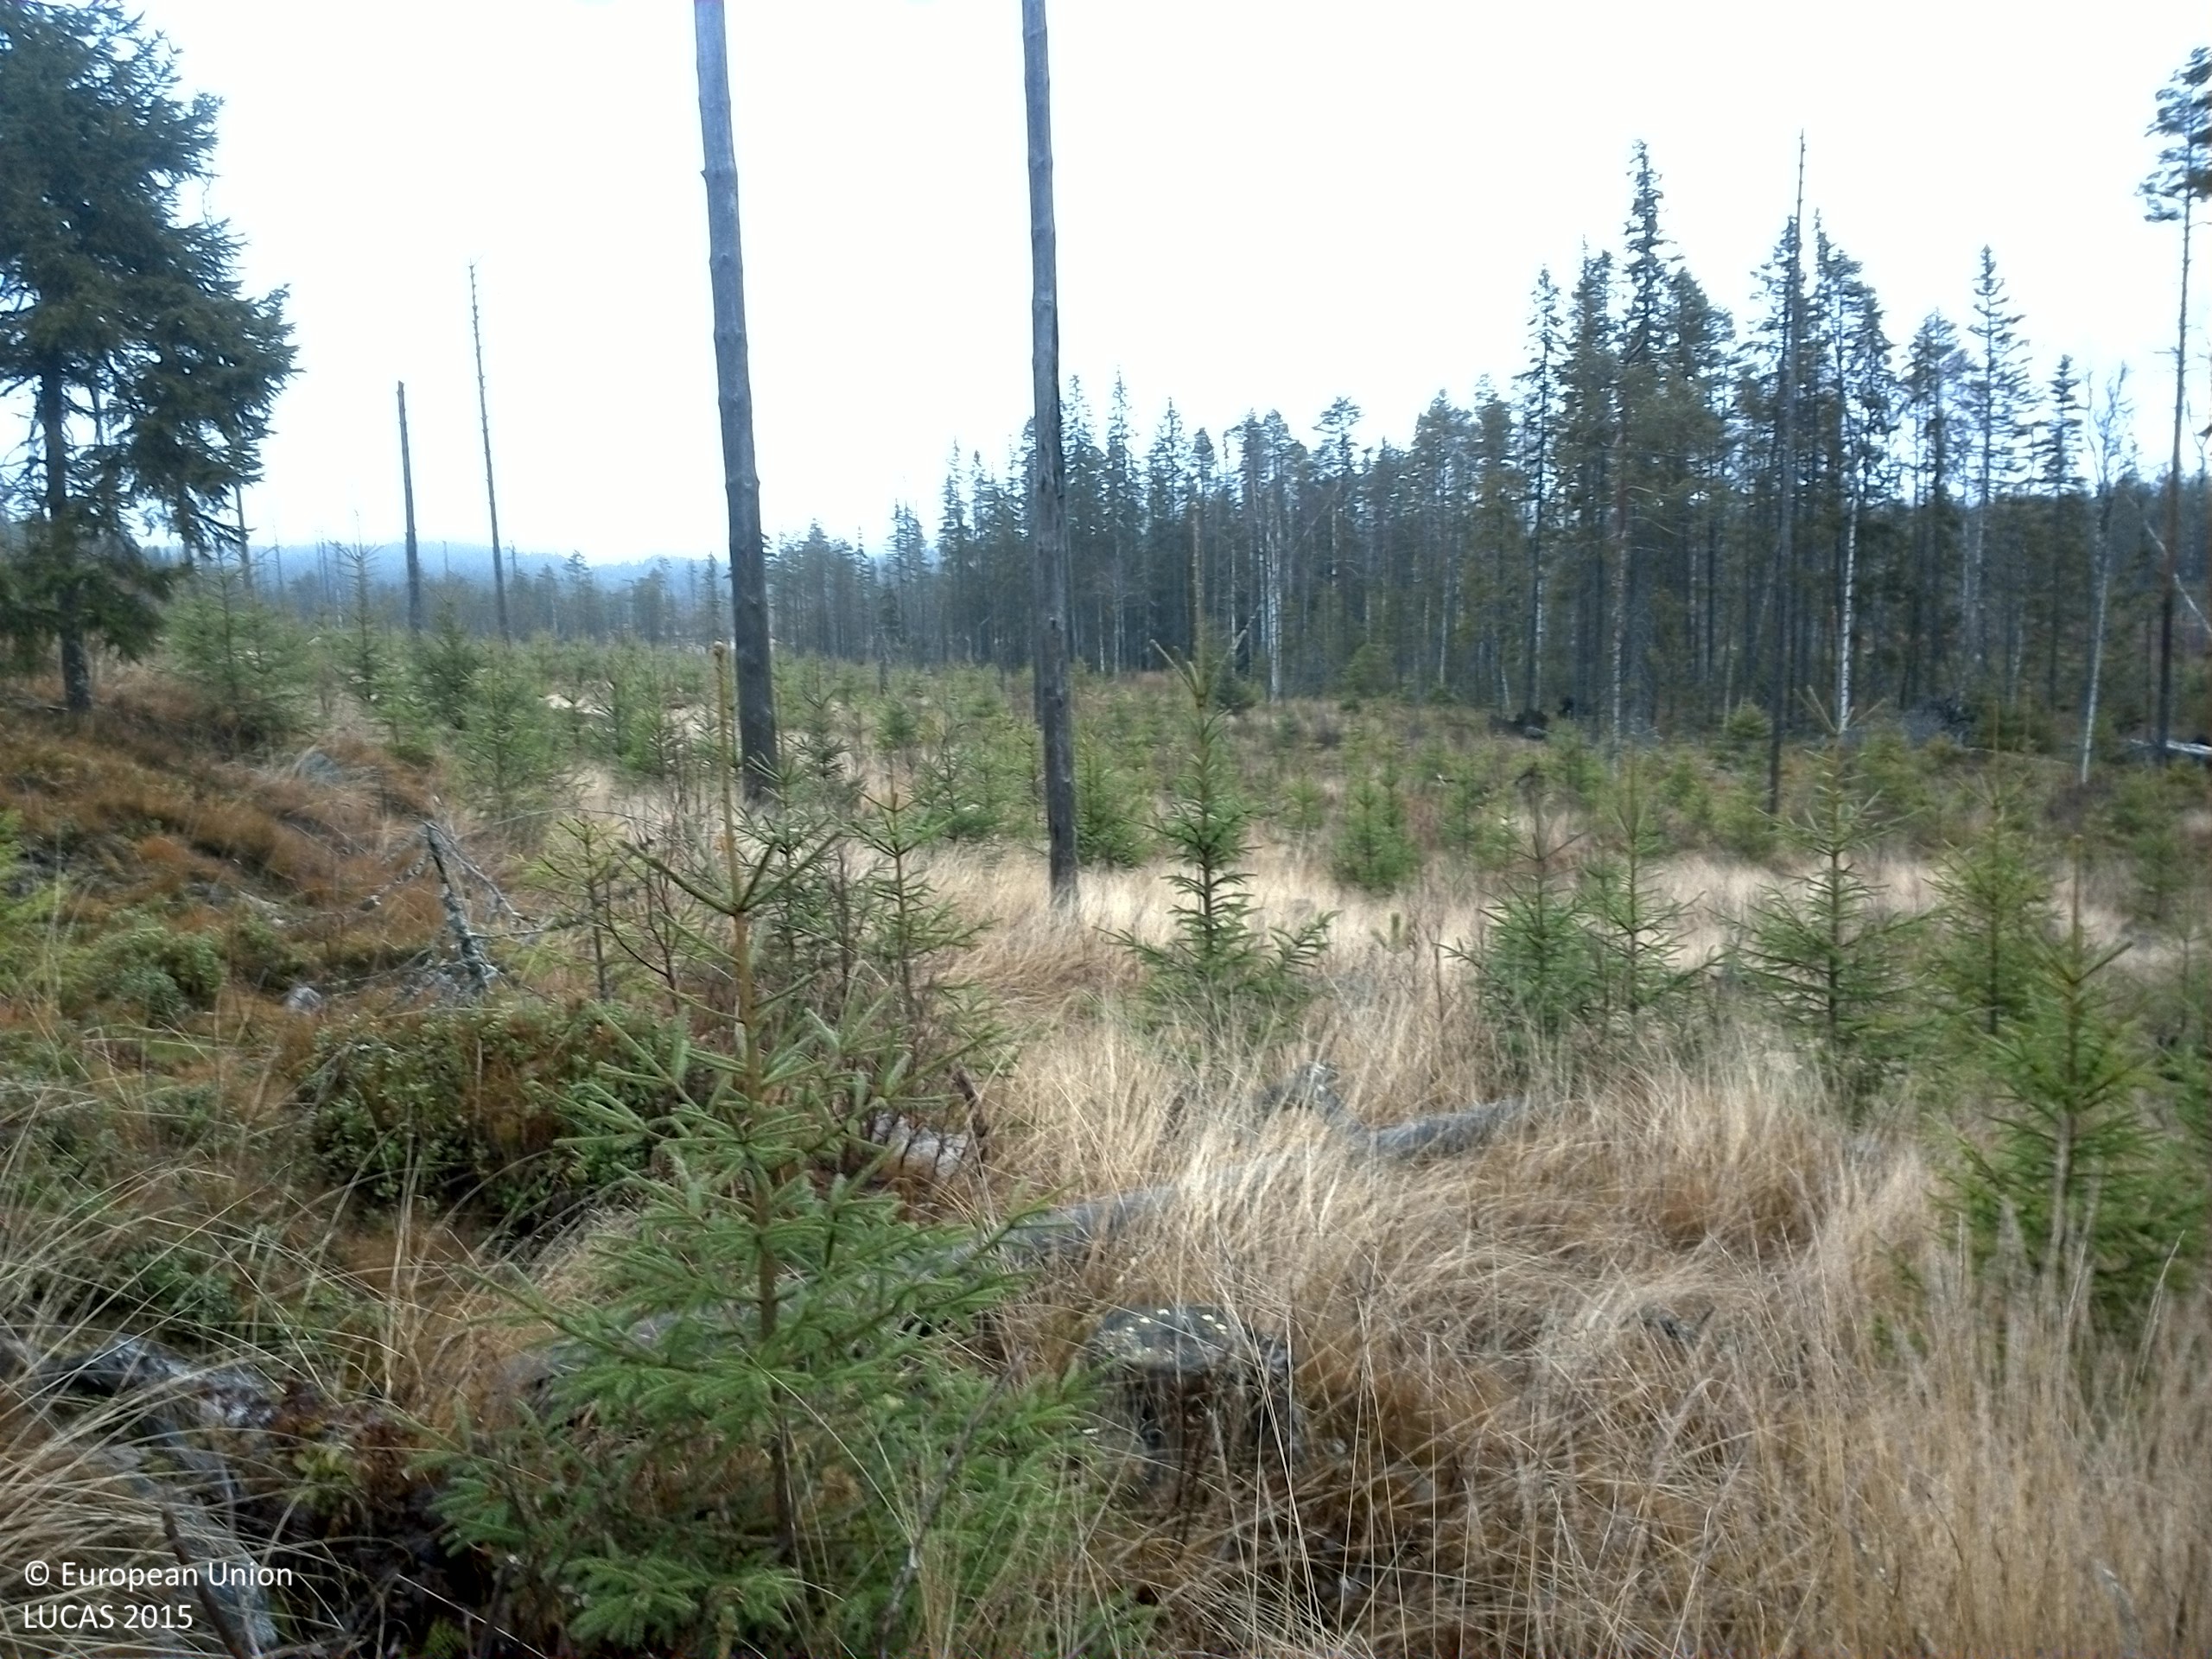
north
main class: Woodland
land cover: Spruce dominated mixed woodland
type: boreal forest
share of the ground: 25 - 50 %
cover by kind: herbaceous plants 40 %, coniferous forest trees 25 %, shrubs 20 %, broadleaved forest trees 10 %, lichens and mosses 5 %
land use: Forestry
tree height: < 5 m
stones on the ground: 10 - 25 %
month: November
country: SE
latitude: 60.0694
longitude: 14.6071
